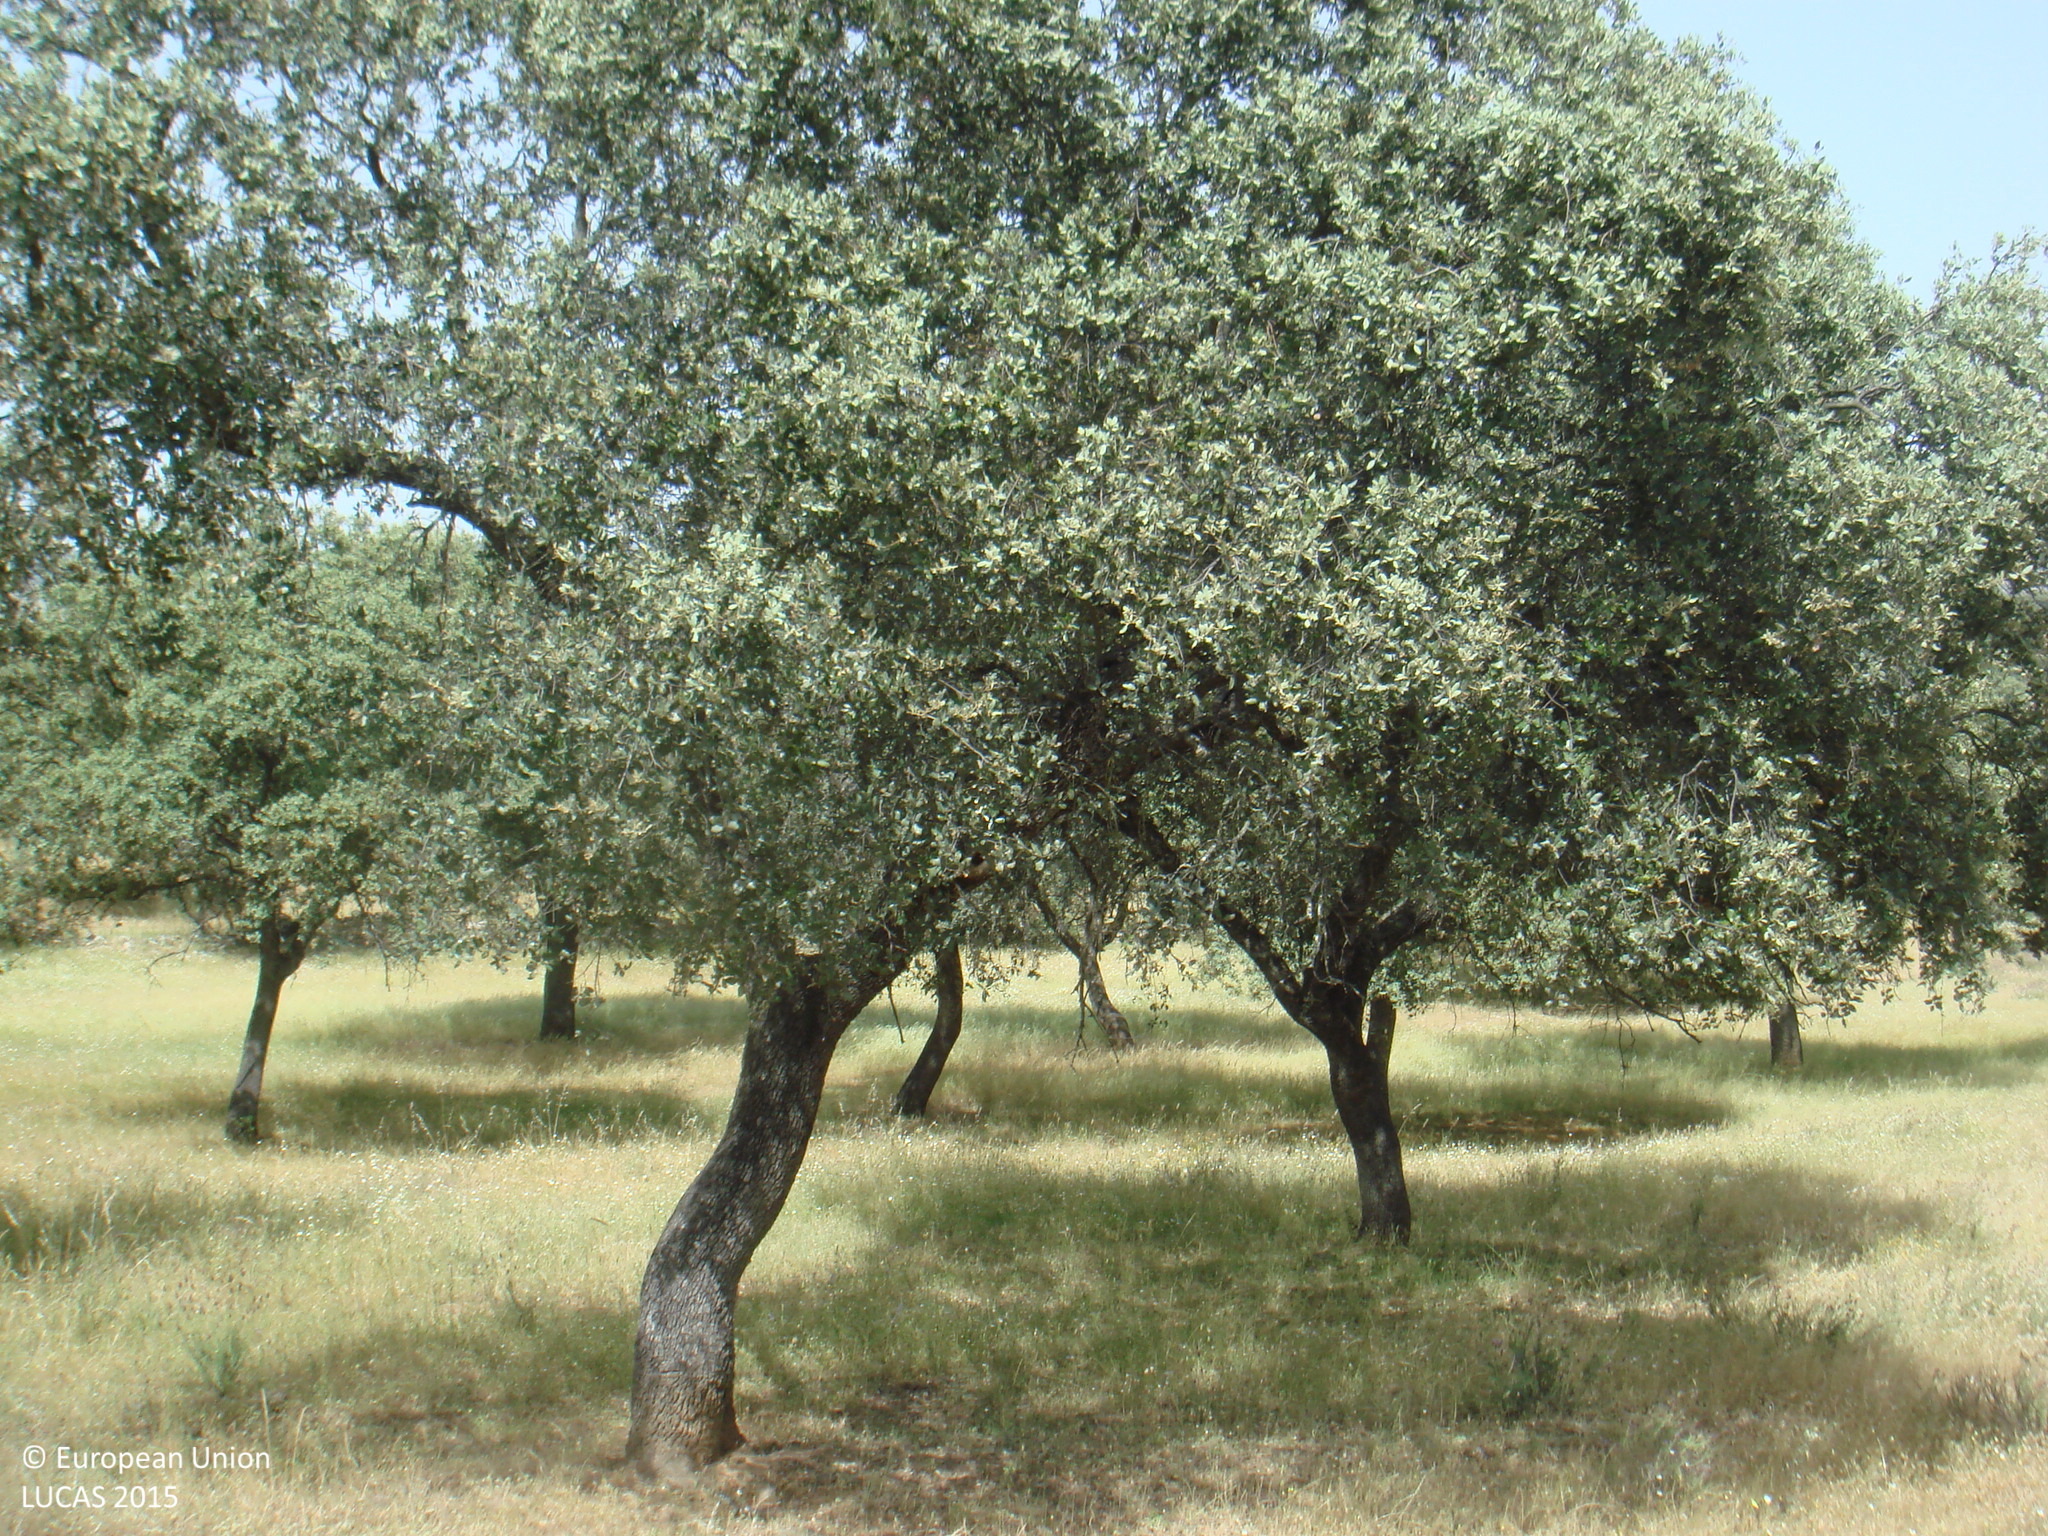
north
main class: Woodland
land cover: Broadleaved woodland
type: broadleaved evergreen forest
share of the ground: 25 - 50 %
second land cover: Spontaneously vegetated surfaces
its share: > 75 %
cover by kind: broadleaved forest trees 50 %, herbaceous plants 50 %
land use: Forestry
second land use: Agriculture (excluding fallow land and kitchen gardens)
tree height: > 5 m
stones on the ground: 10 - 25 %
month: May
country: ES
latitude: 38.5369
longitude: -4.7666
